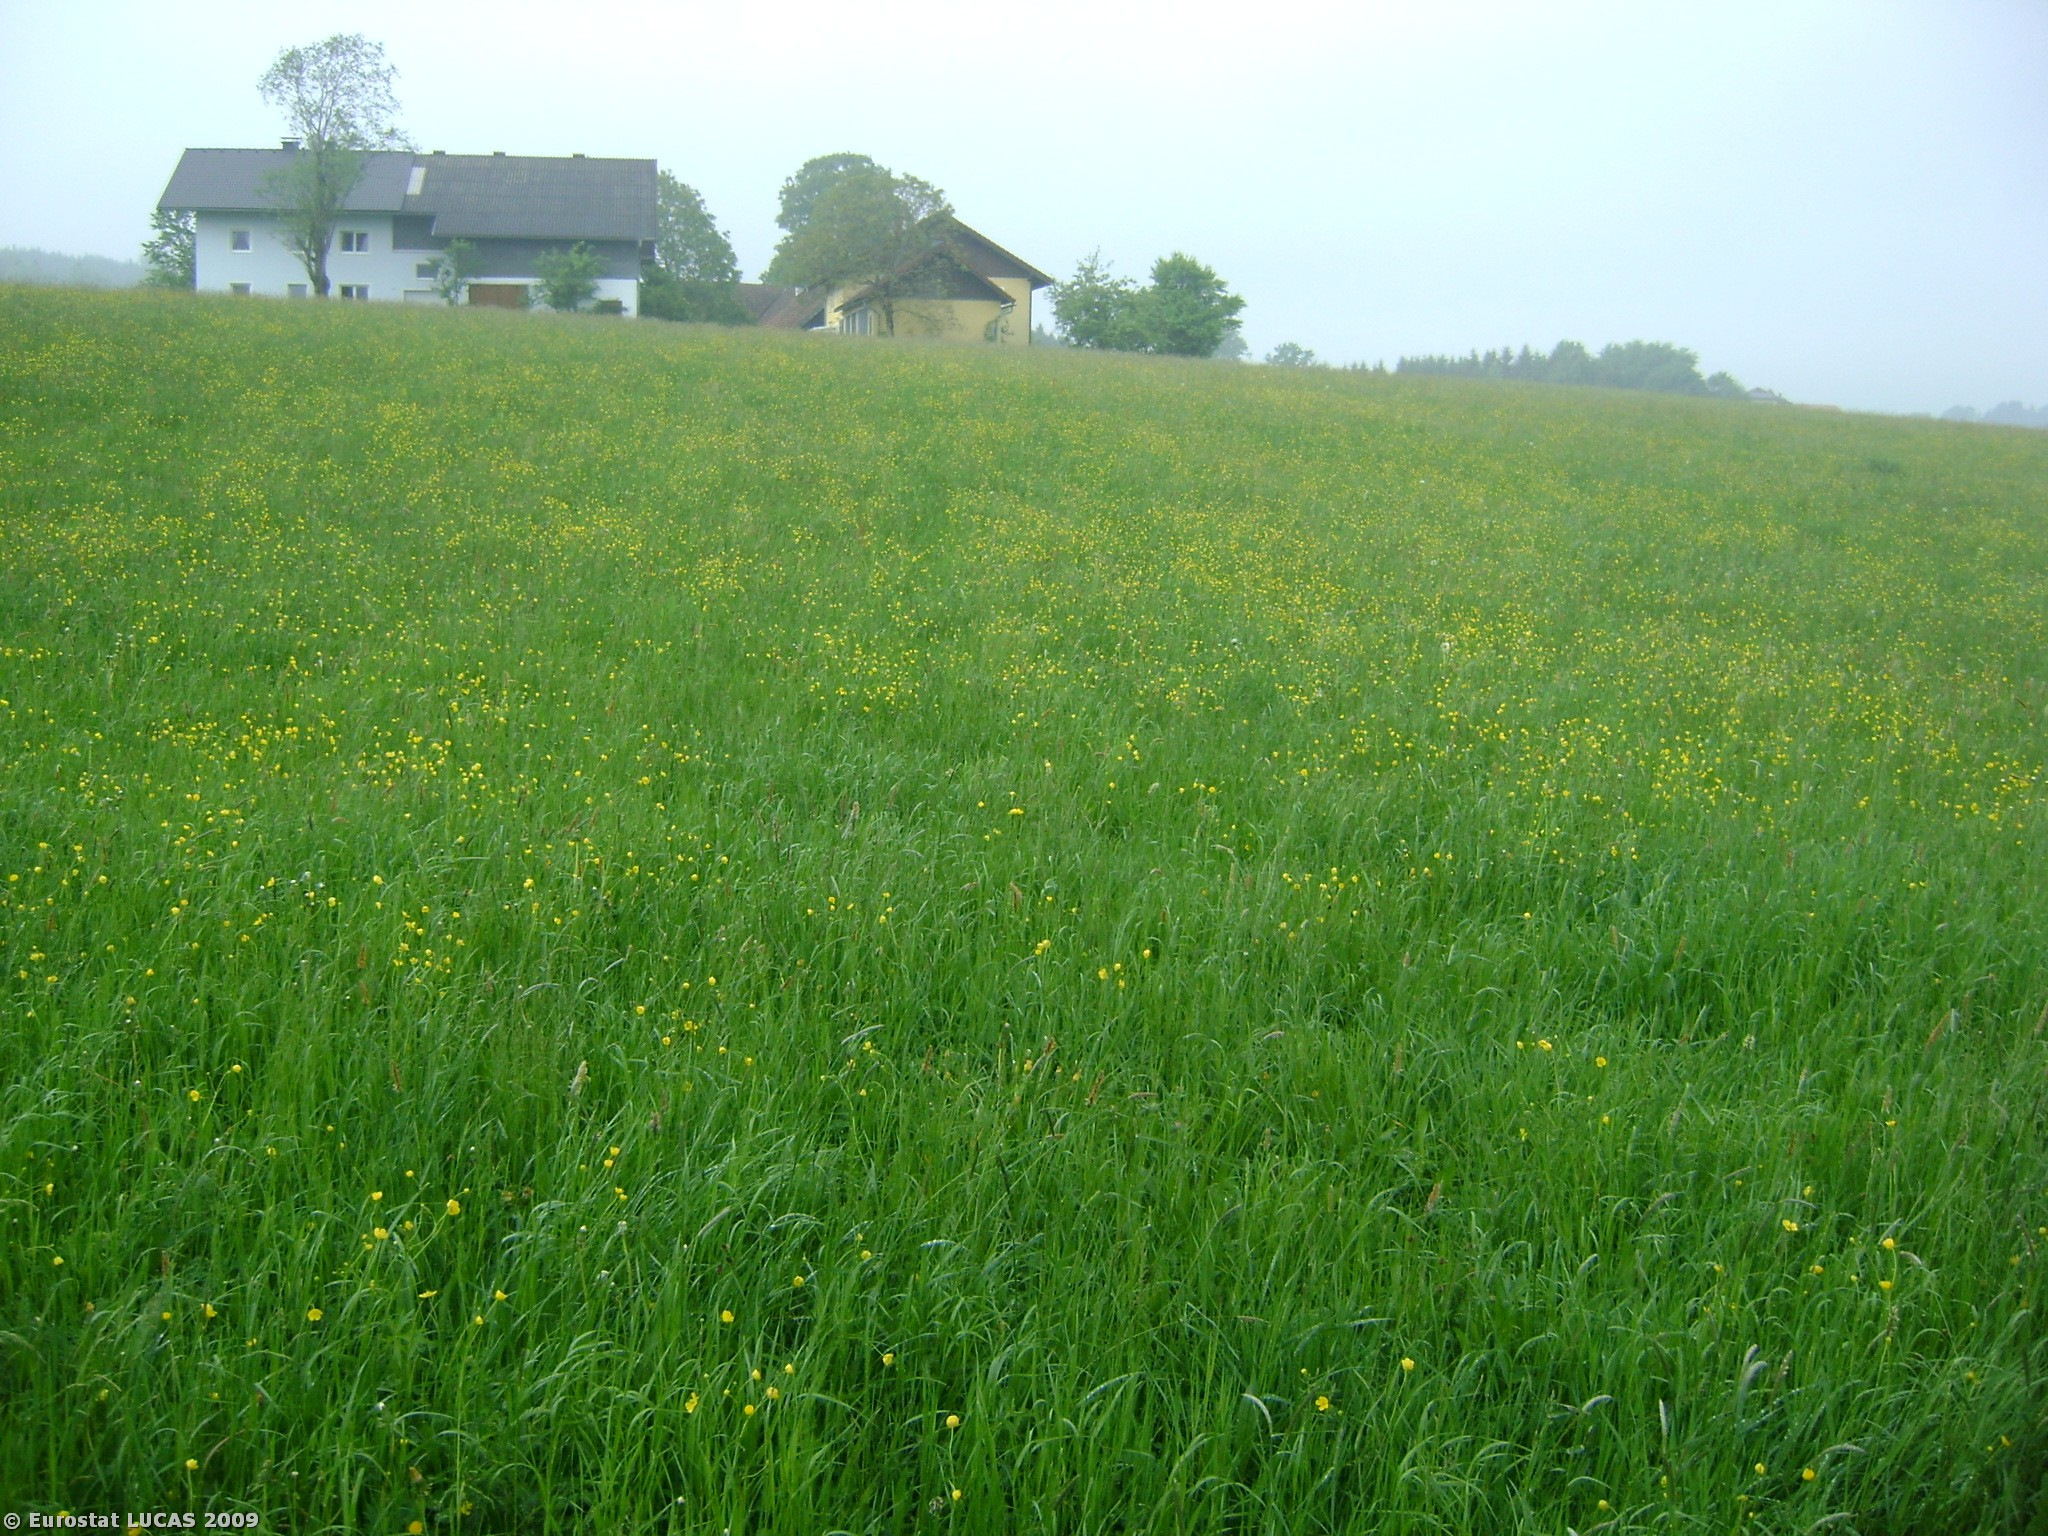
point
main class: Grassland
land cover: Grassland without tree/shrub cover
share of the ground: > 75 %
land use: Agriculture (excluding fallow land and kitchen gardens)
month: May
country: AT
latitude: 47.9594
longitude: 13.2531
